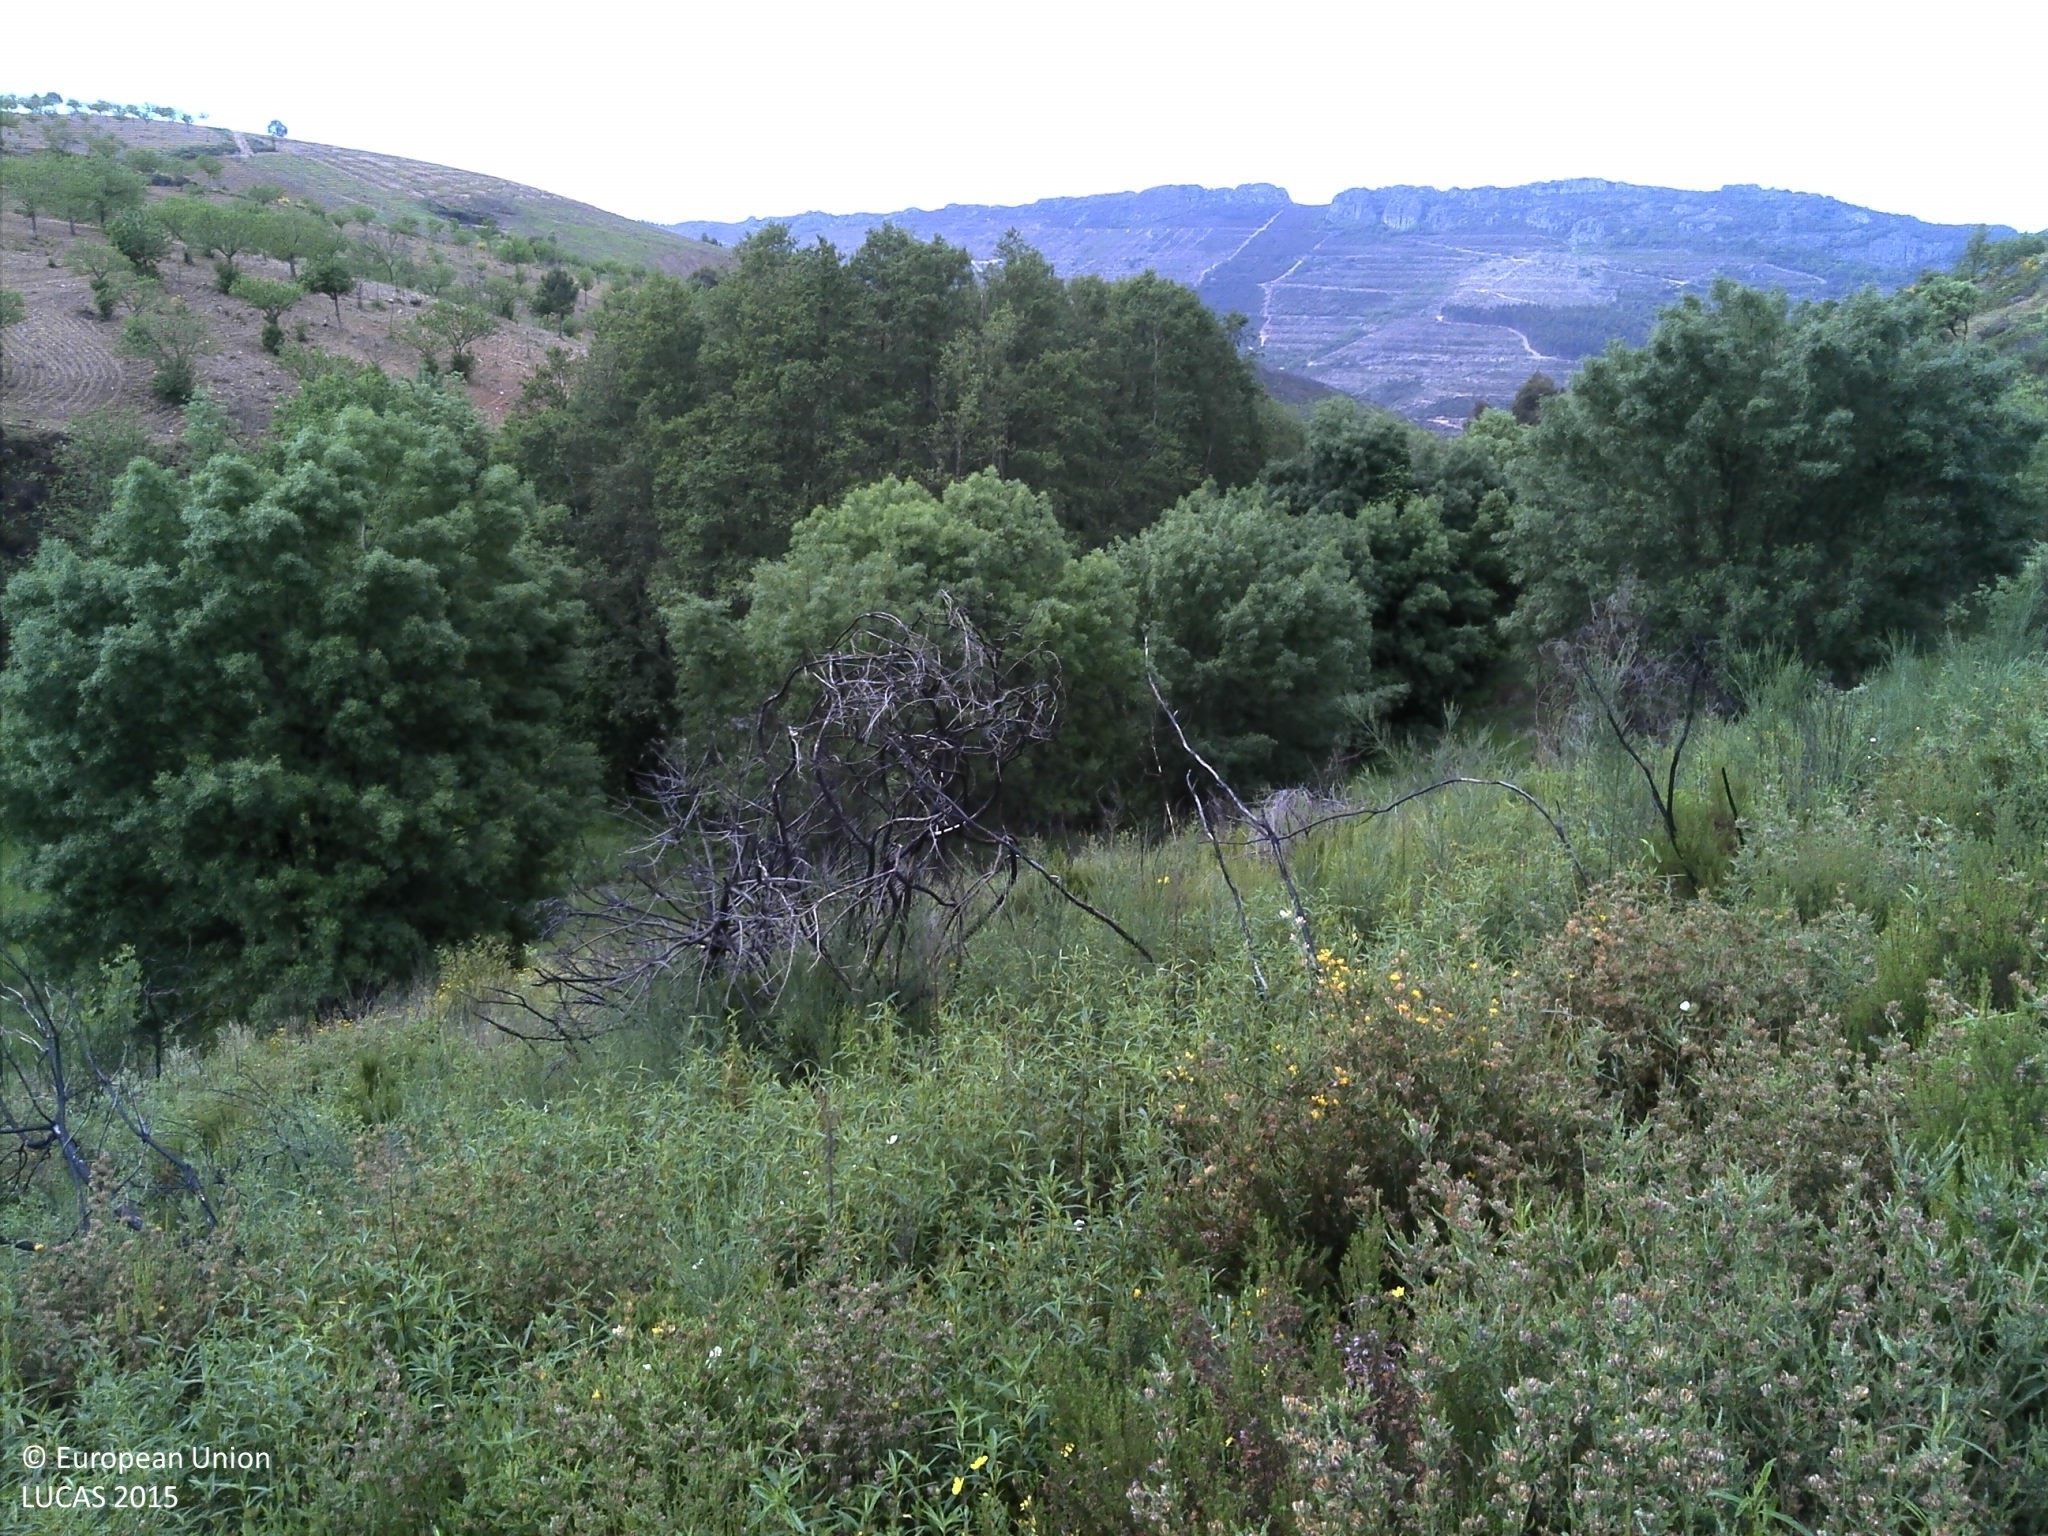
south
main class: Shrubland
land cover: Shrubland with sparse tree cover
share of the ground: > 75 %
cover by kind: shrubs 80 %, unconsolidated bare surface 15 %, broadleaved forest trees 5 %
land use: Forestry
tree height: < 5 m
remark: Burnt area
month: May
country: PT
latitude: 41.7677
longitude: -7.0447
